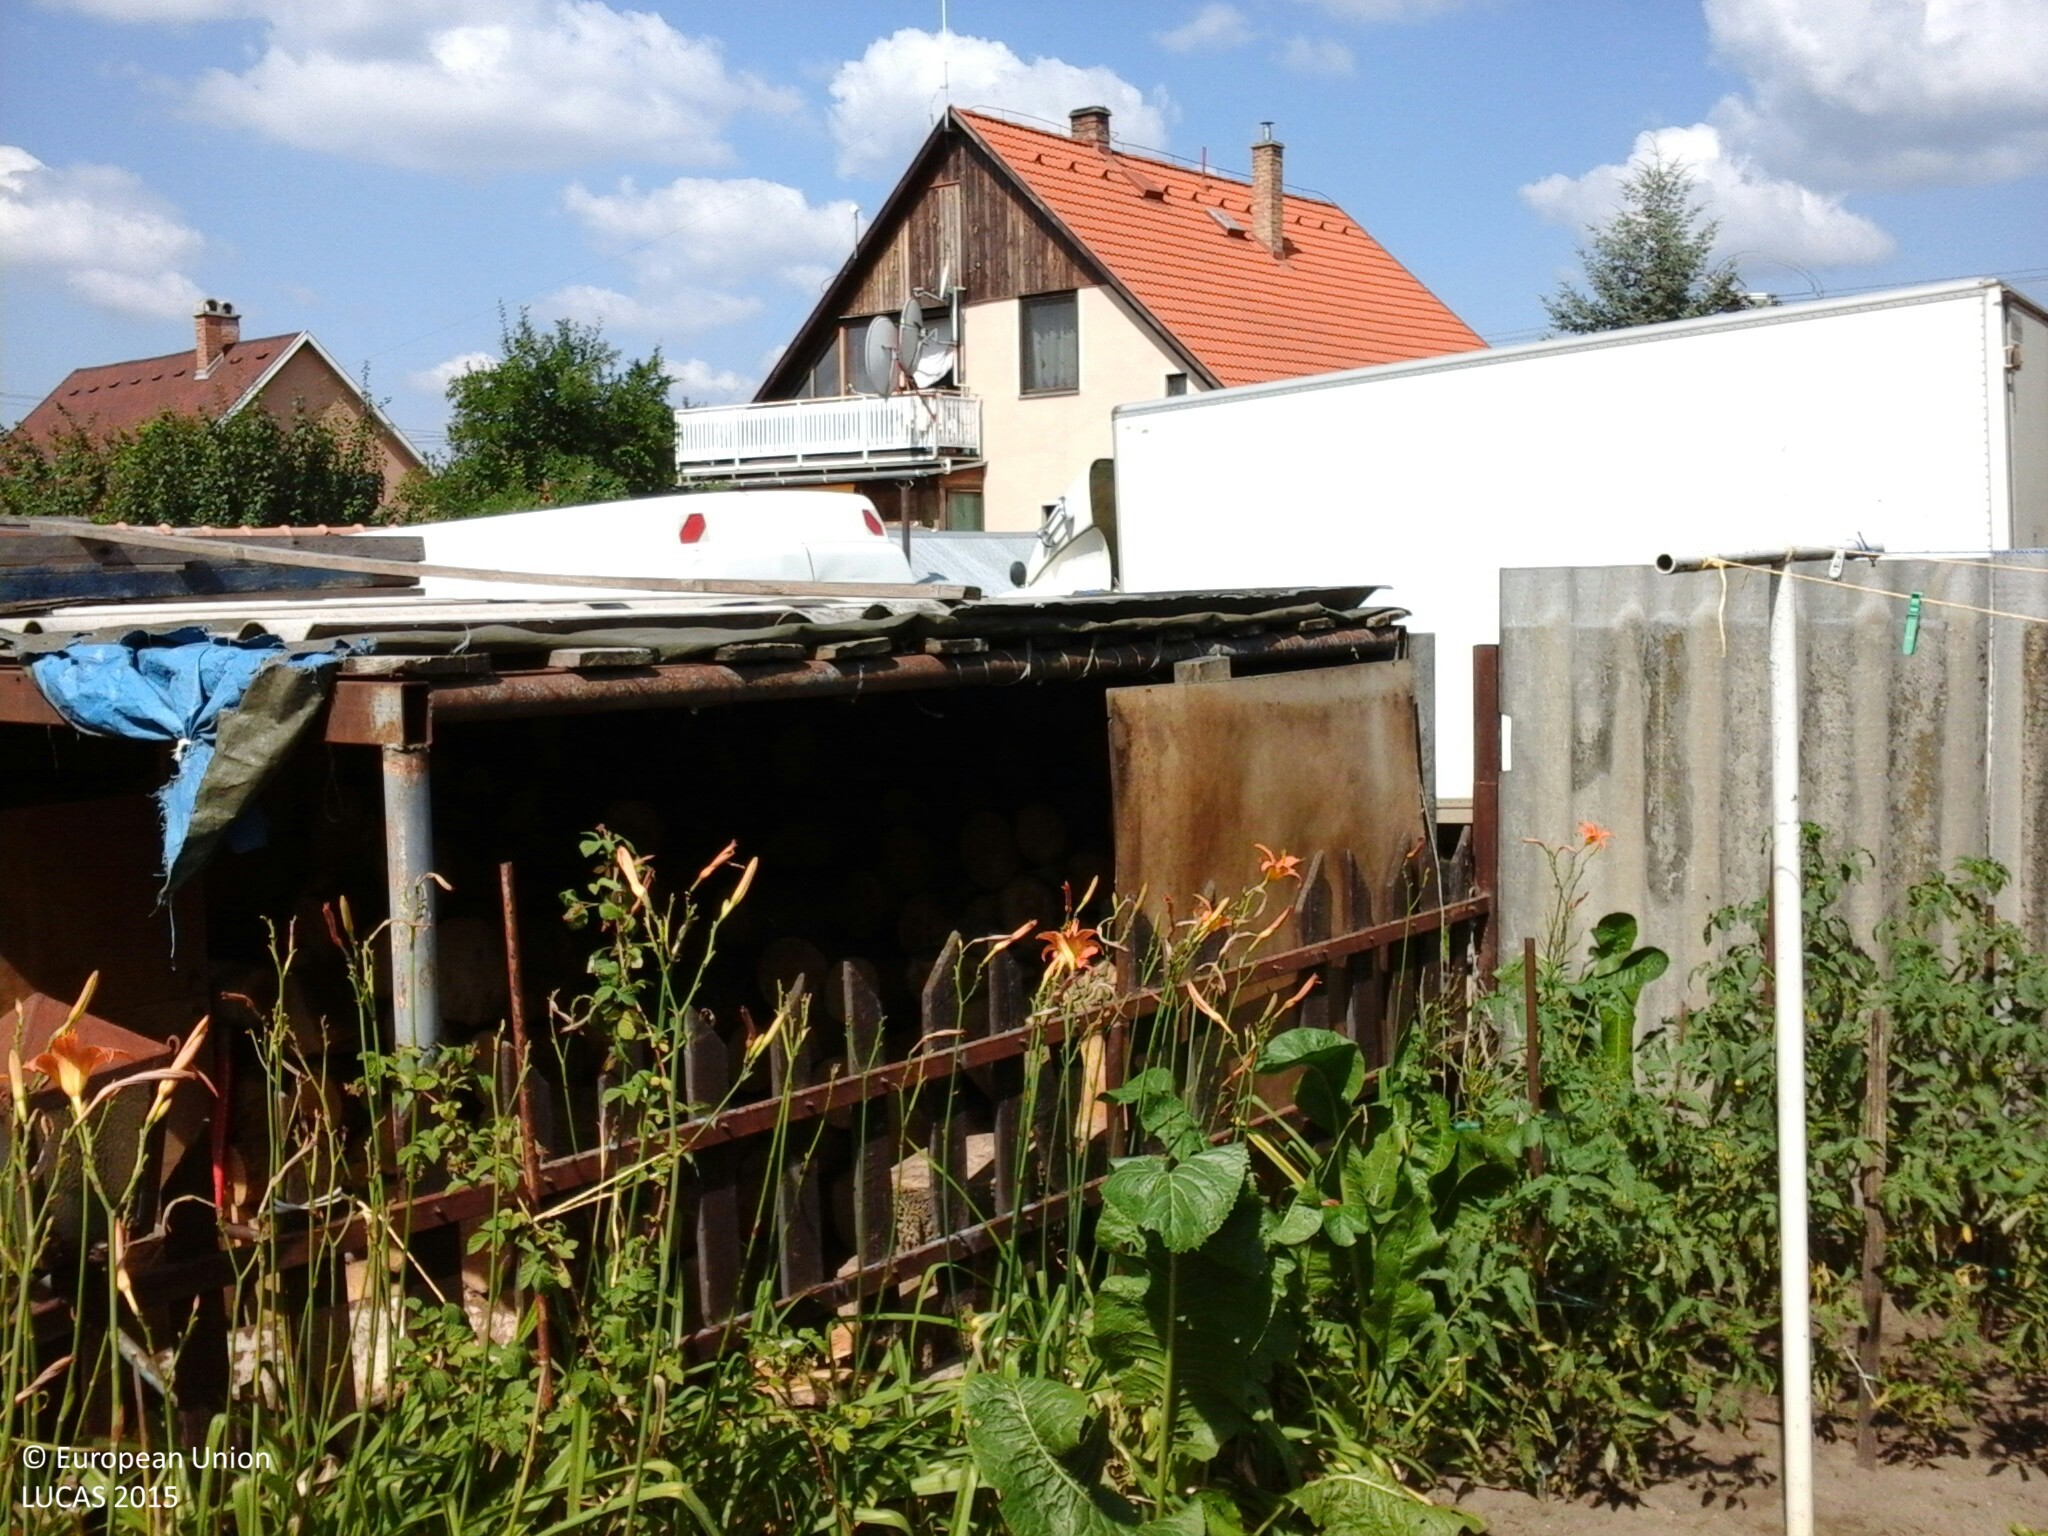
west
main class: Cropland
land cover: Other fruit trees and berries
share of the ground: 10 - 25 %
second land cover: Tomatoes
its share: 25 - 50 %
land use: Kitchen garden
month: June
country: HU
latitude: 47.6486
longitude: 19.2993
